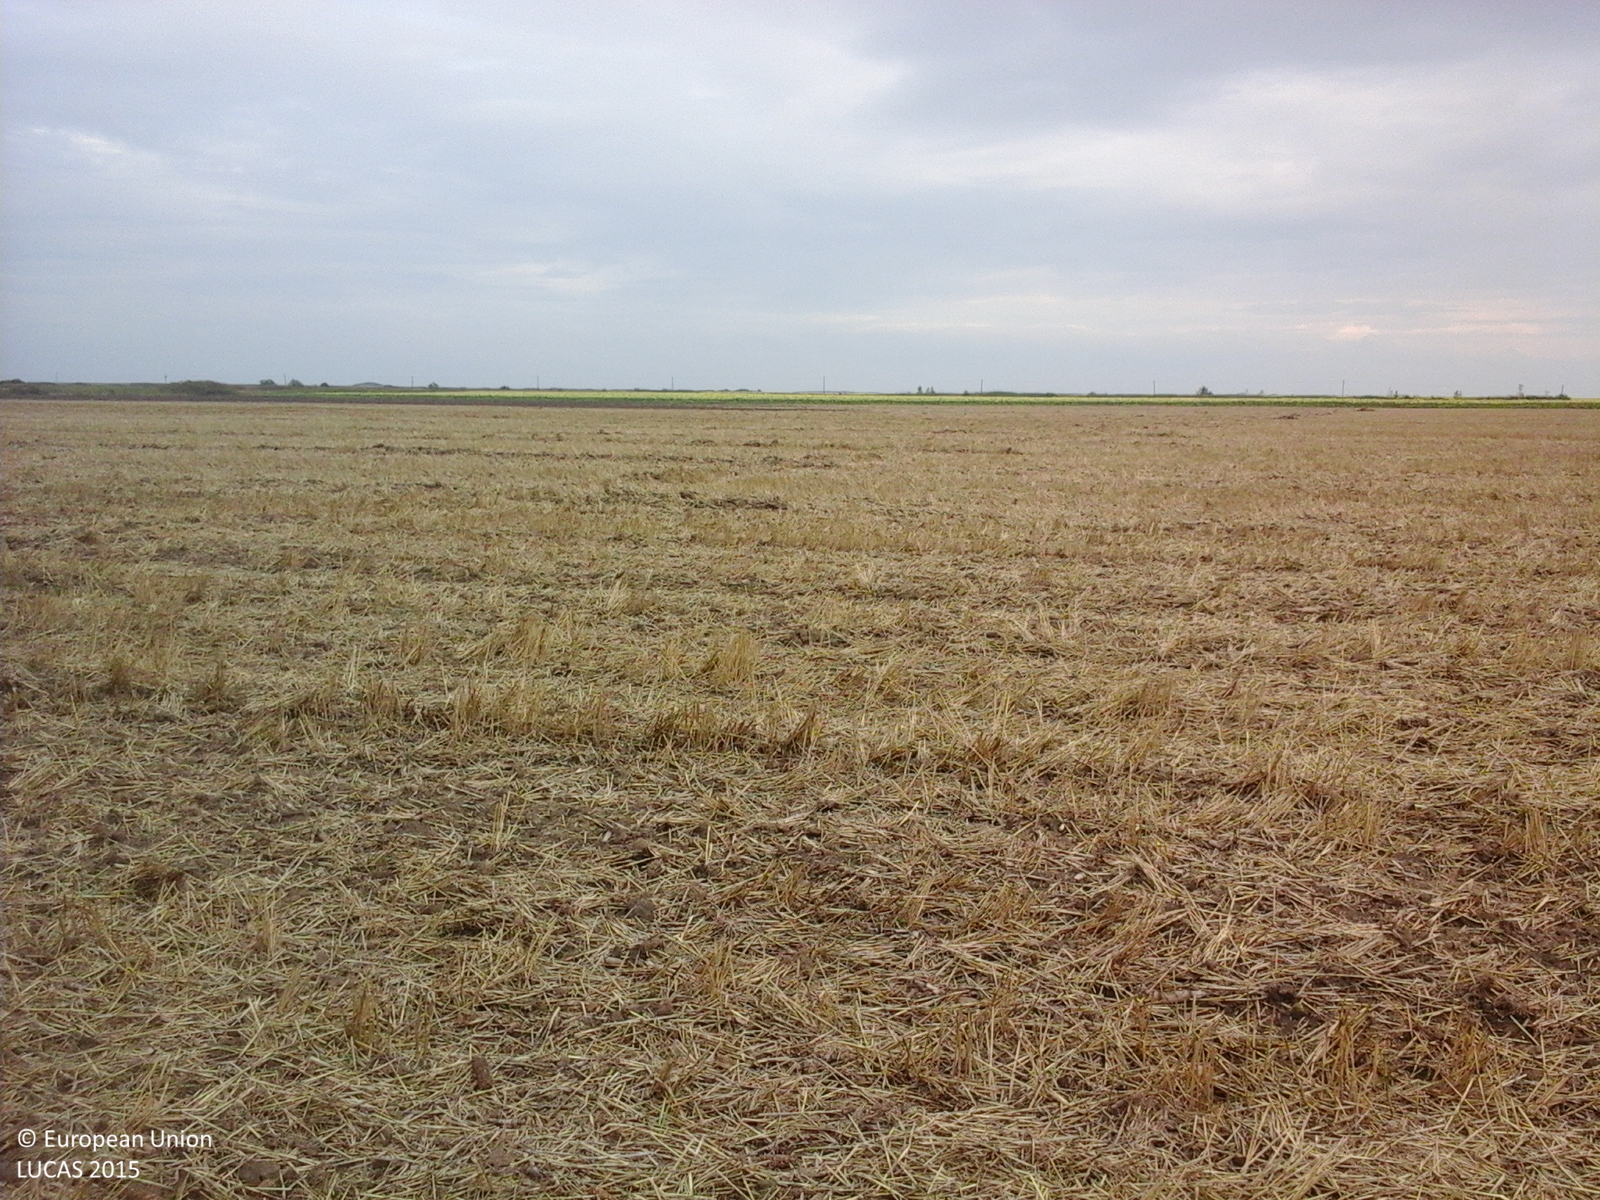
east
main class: Cropland
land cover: Common wheat
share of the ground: 50 - 75 %
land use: Agriculture (excluding fallow land and kitchen gardens)
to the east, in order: Common wheat
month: August
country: RO
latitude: 46.0070
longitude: 20.5757
